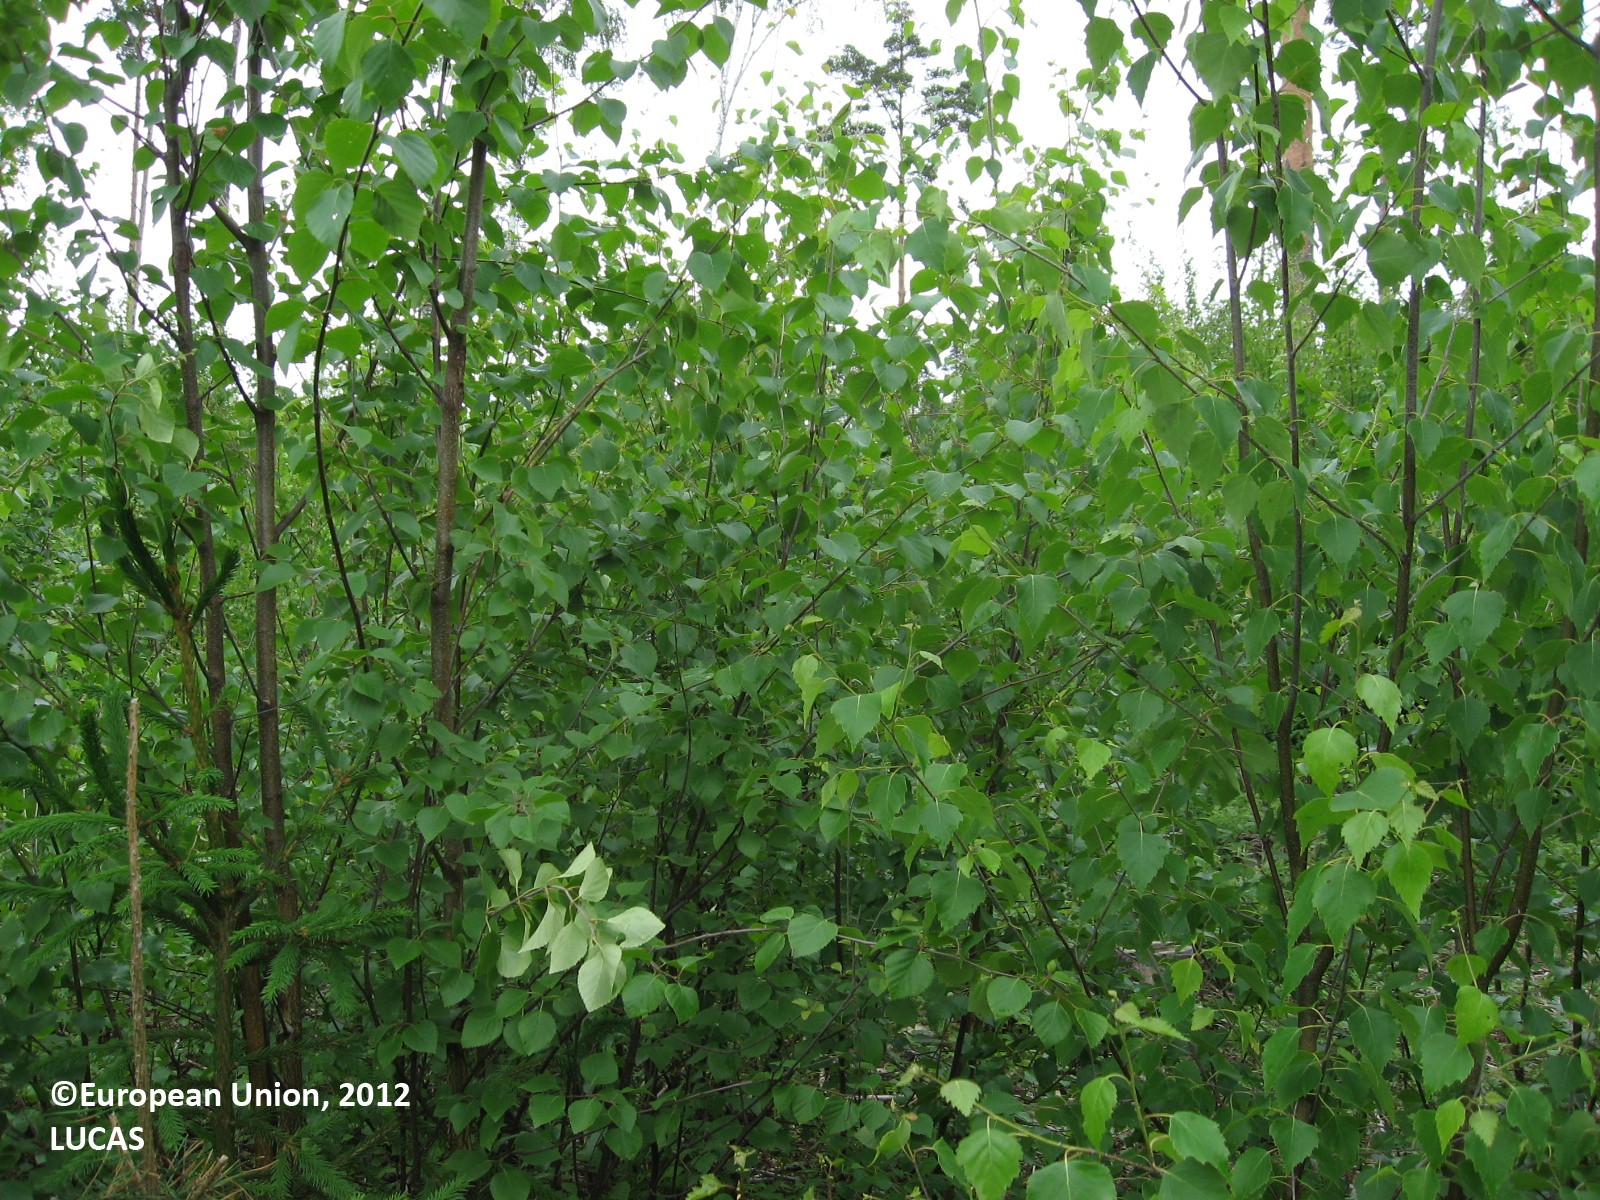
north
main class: Woodland
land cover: Broadleaved woodland
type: boreal forest
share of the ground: > 75 %
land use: Forestry
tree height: > 5 m
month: June
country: FI
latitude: 60.4568
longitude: 26.3144
